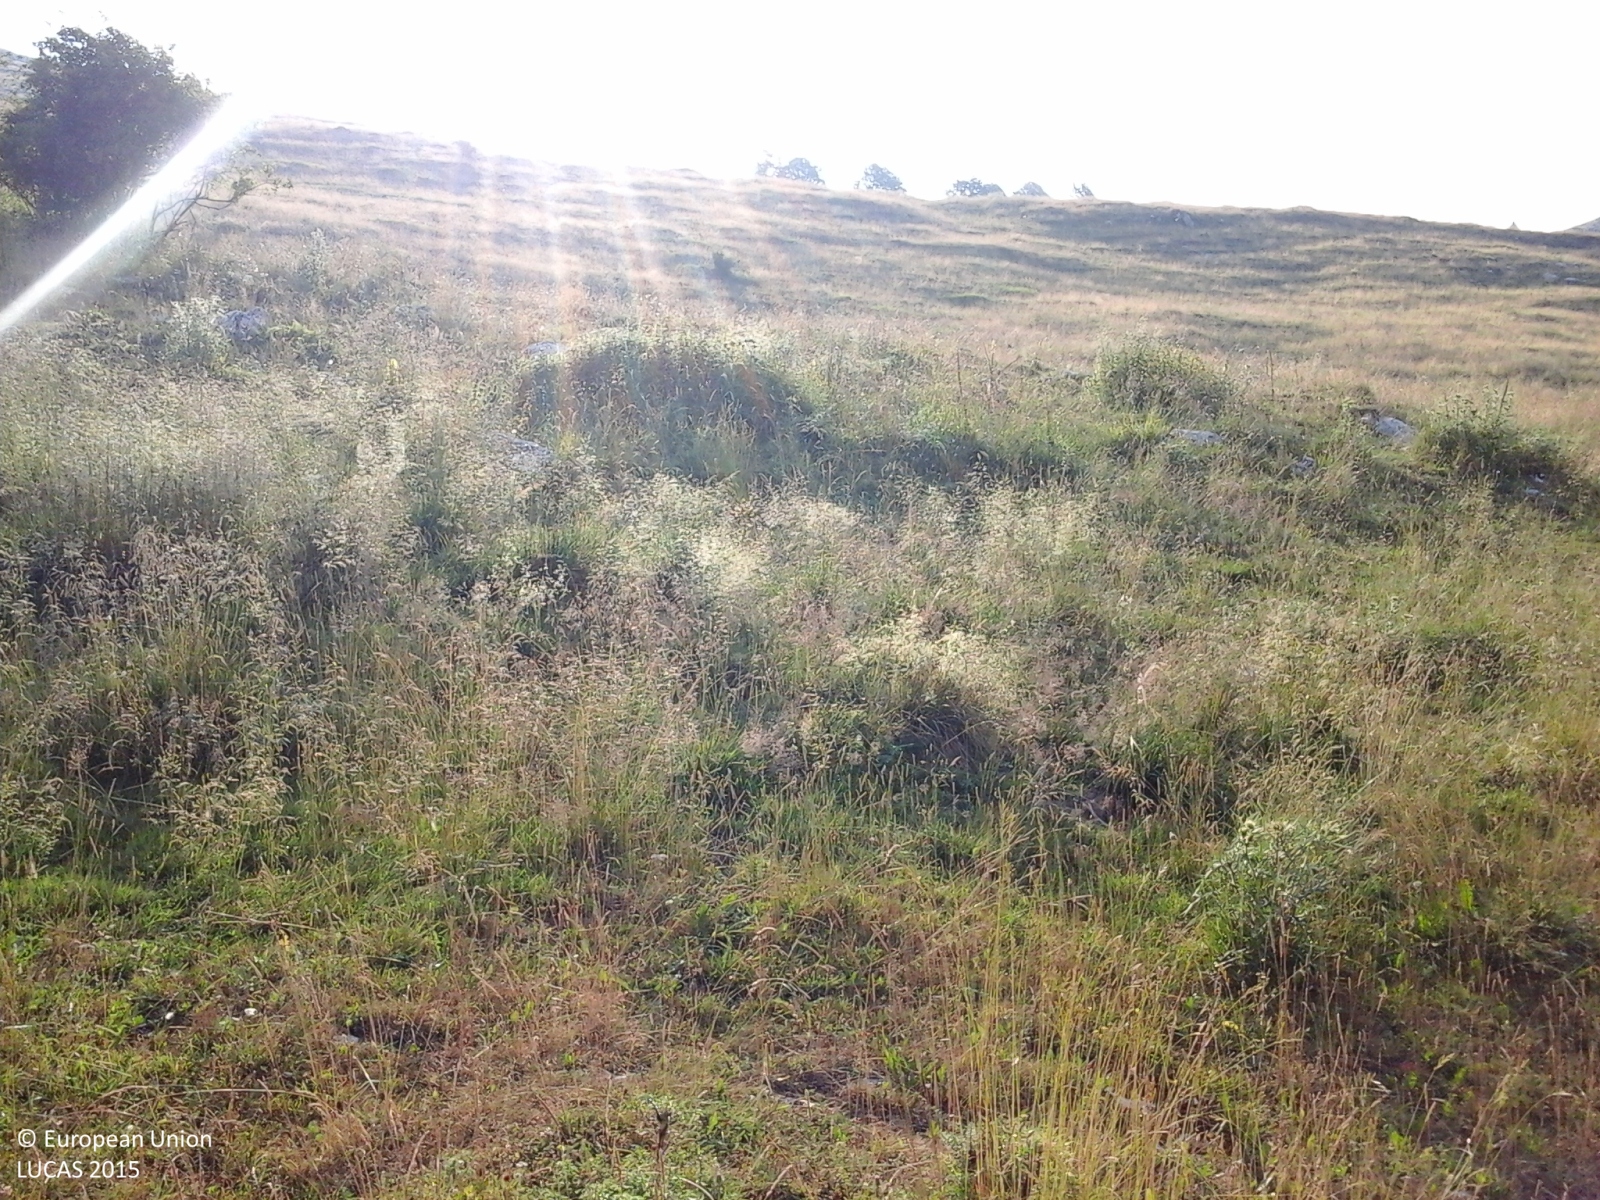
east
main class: Grassland
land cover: Grassland without tree/shrub cover
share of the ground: > 75 %
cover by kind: herbaceous plants 100 %
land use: Agriculture (excluding fallow land and kitchen gardens)
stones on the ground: 25 - 50 %
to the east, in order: Grassland without tree/shrub cover; Dry stone walls; Grassland without tree/shrub cover
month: July
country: IT
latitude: 45.6790
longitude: 11.0895
